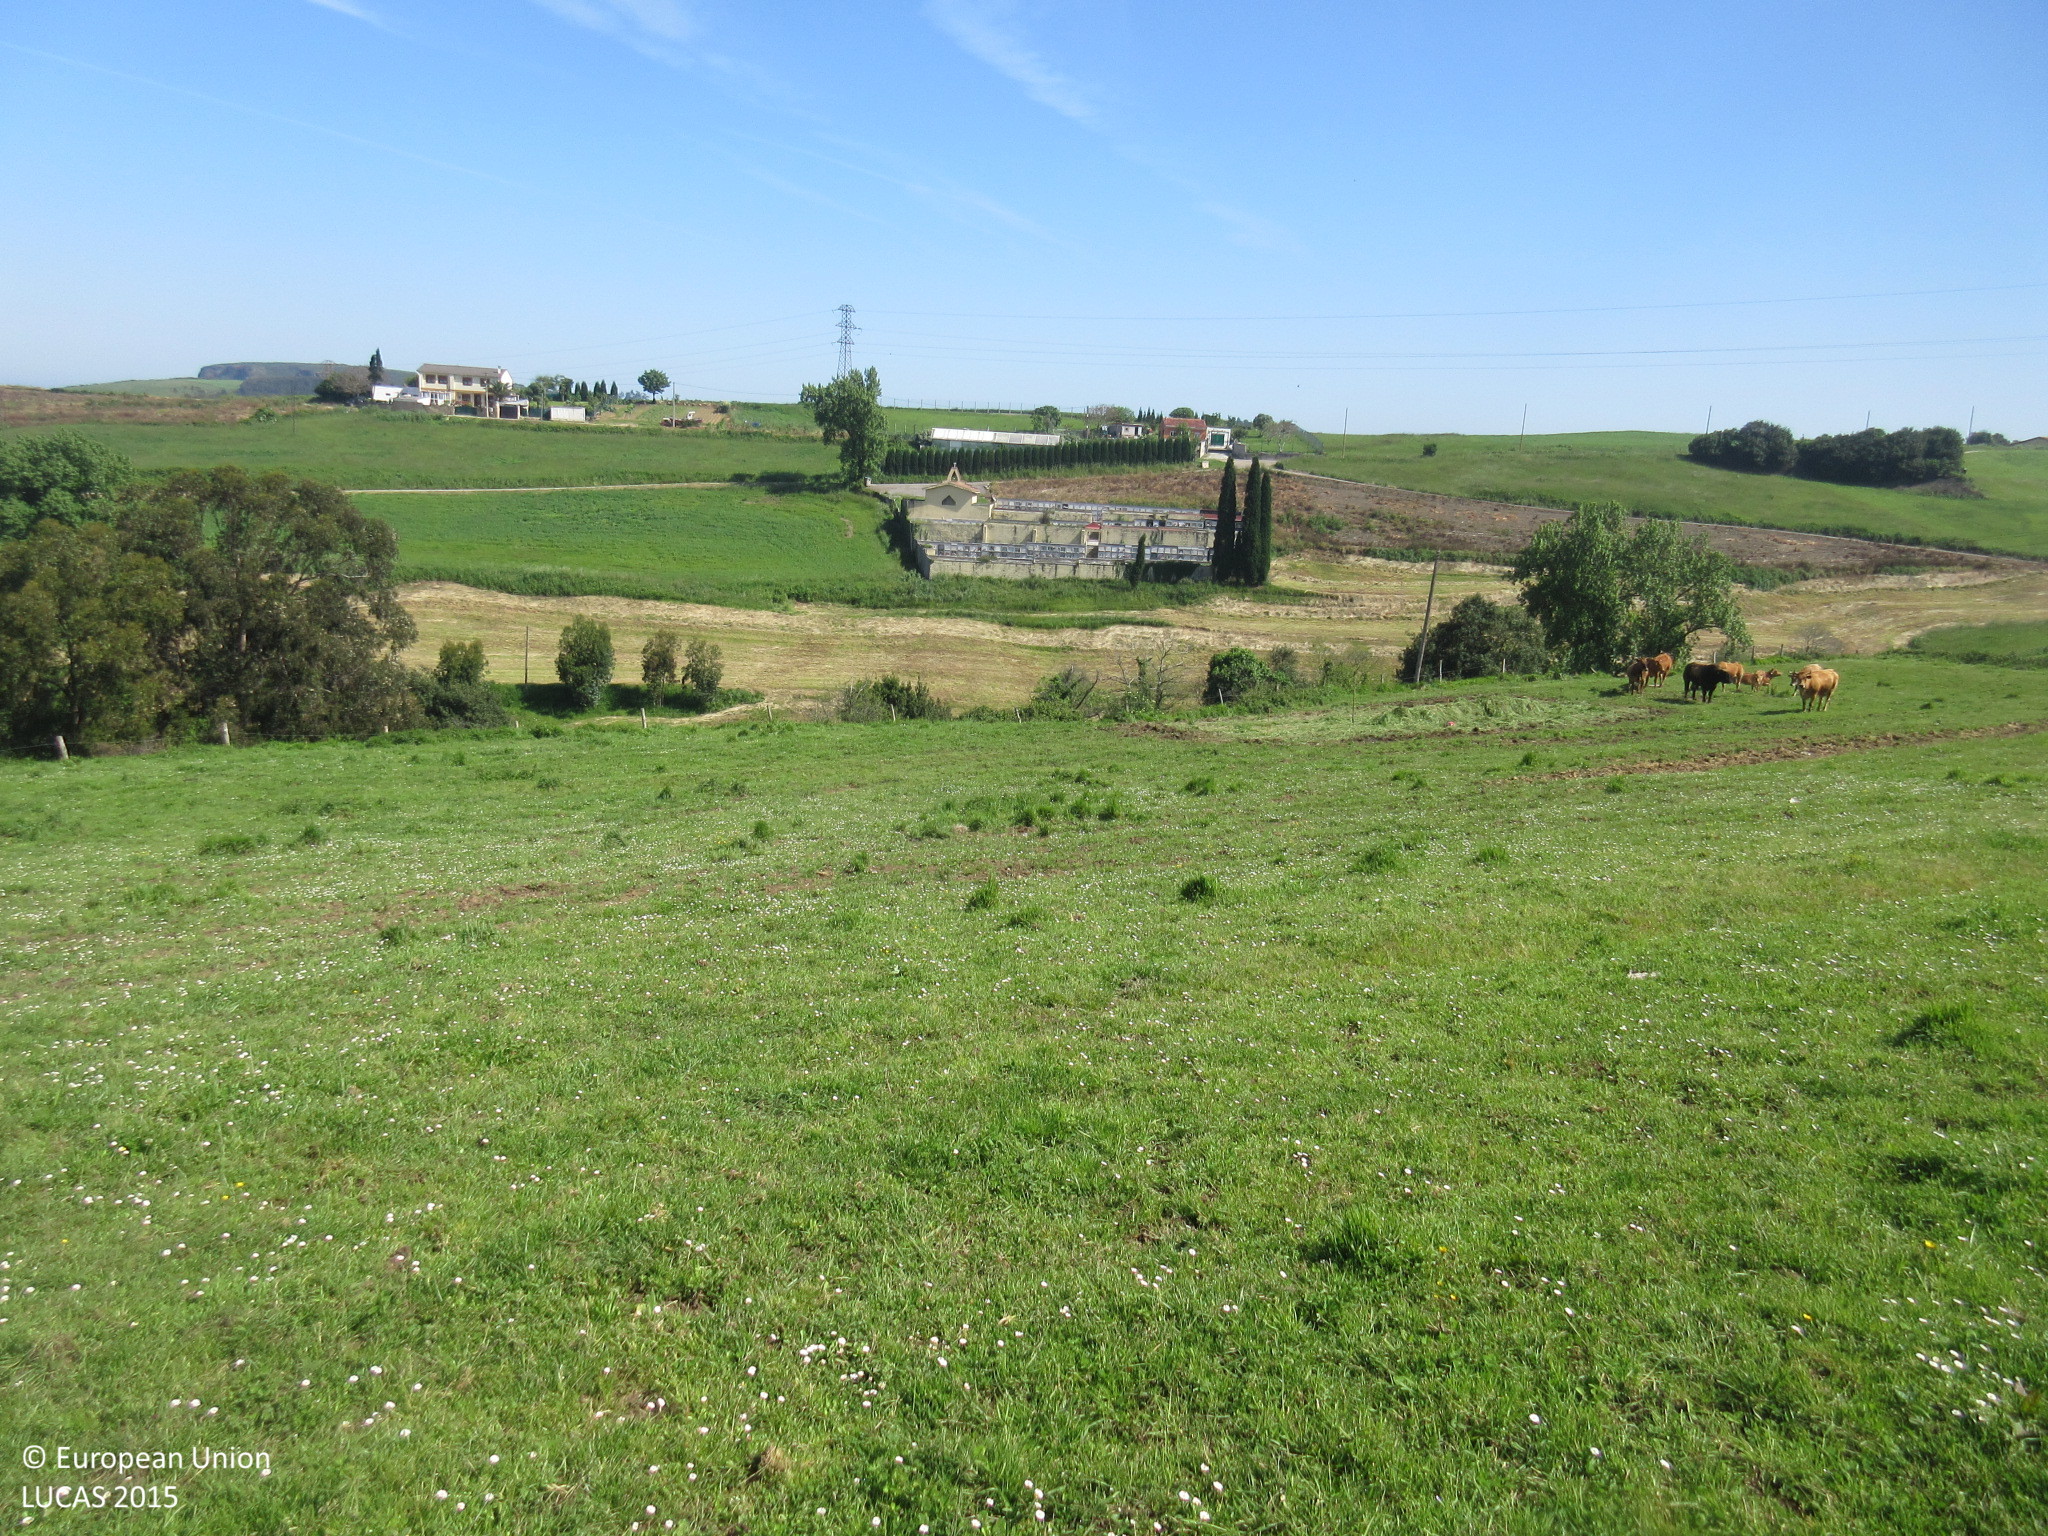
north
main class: Grassland
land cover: Grassland without tree/shrub cover
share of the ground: > 75 %
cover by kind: herbaceous plants 100 %
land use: Agriculture (excluding fallow land and kitchen gardens)
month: May
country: ES
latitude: 43.5911
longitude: -5.9087
